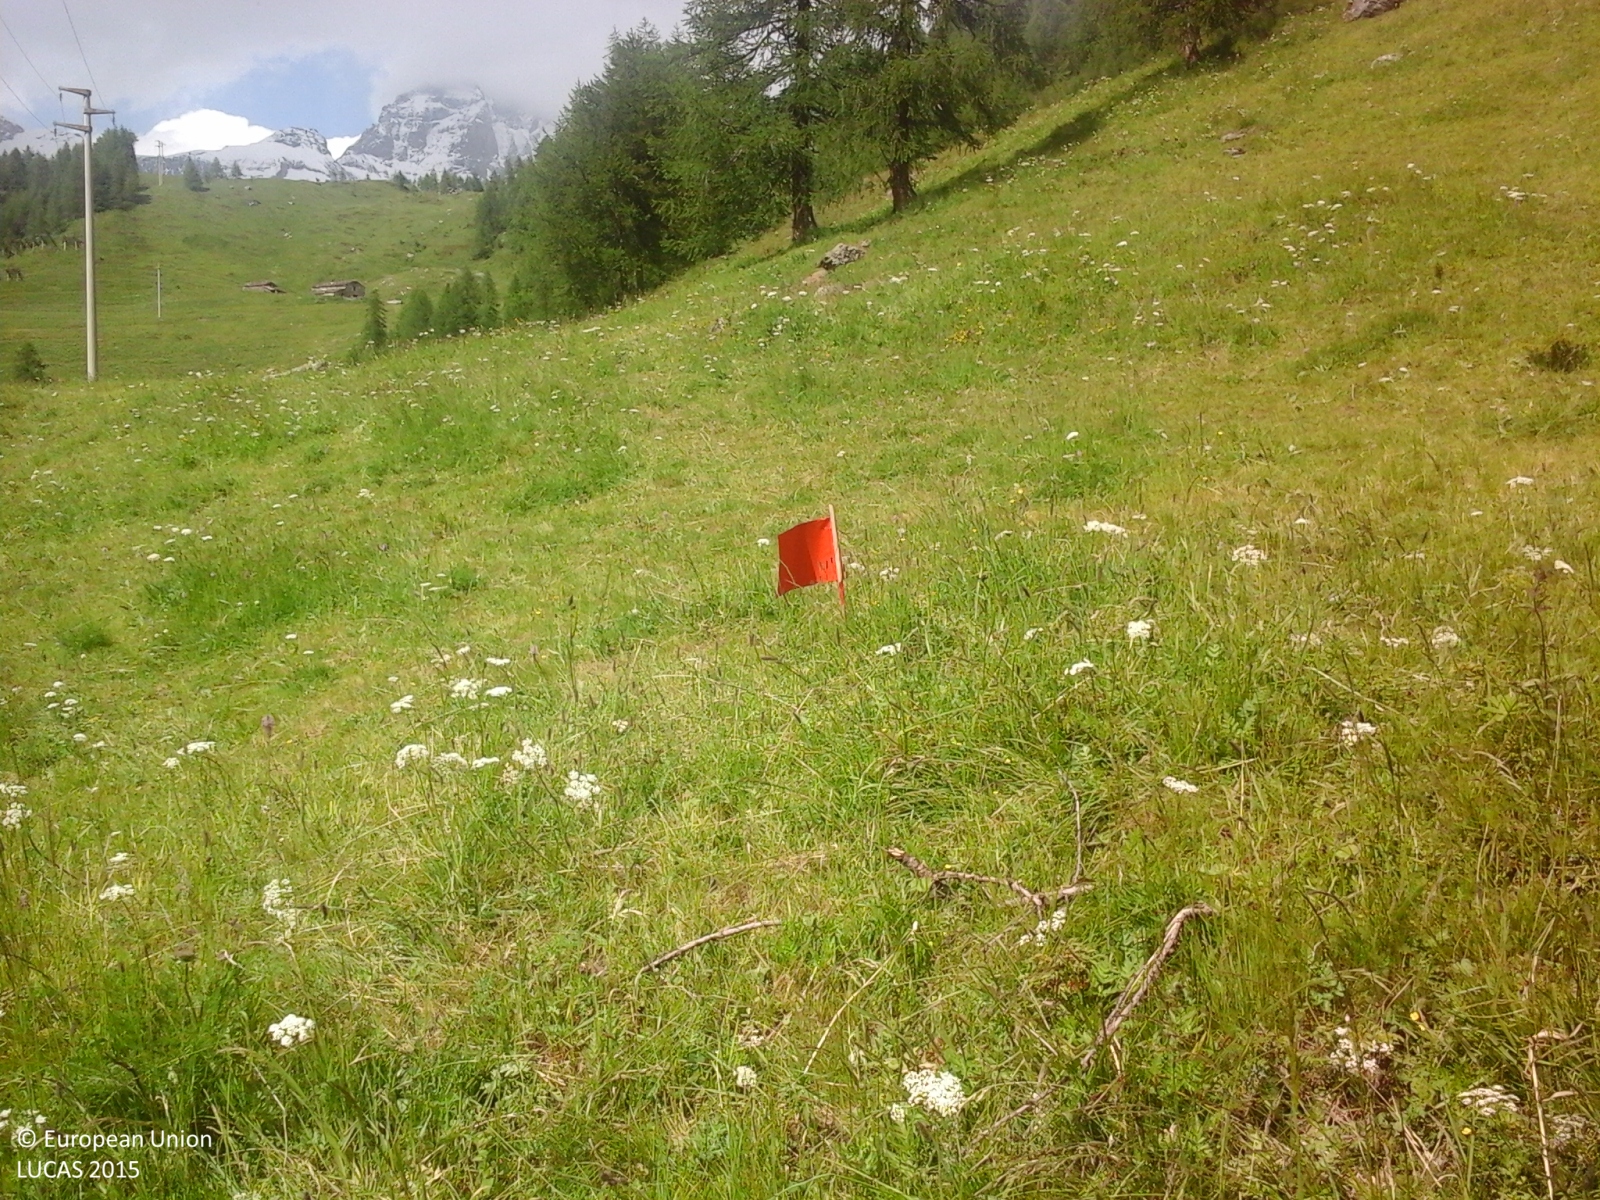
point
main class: Grassland
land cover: Grassland without tree/shrub cover
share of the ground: > 75 %
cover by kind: herbaceous plants 100 %
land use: Agriculture (excluding fallow land and kitchen gardens)
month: June
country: IT
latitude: 45.9102
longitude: 7.6183
